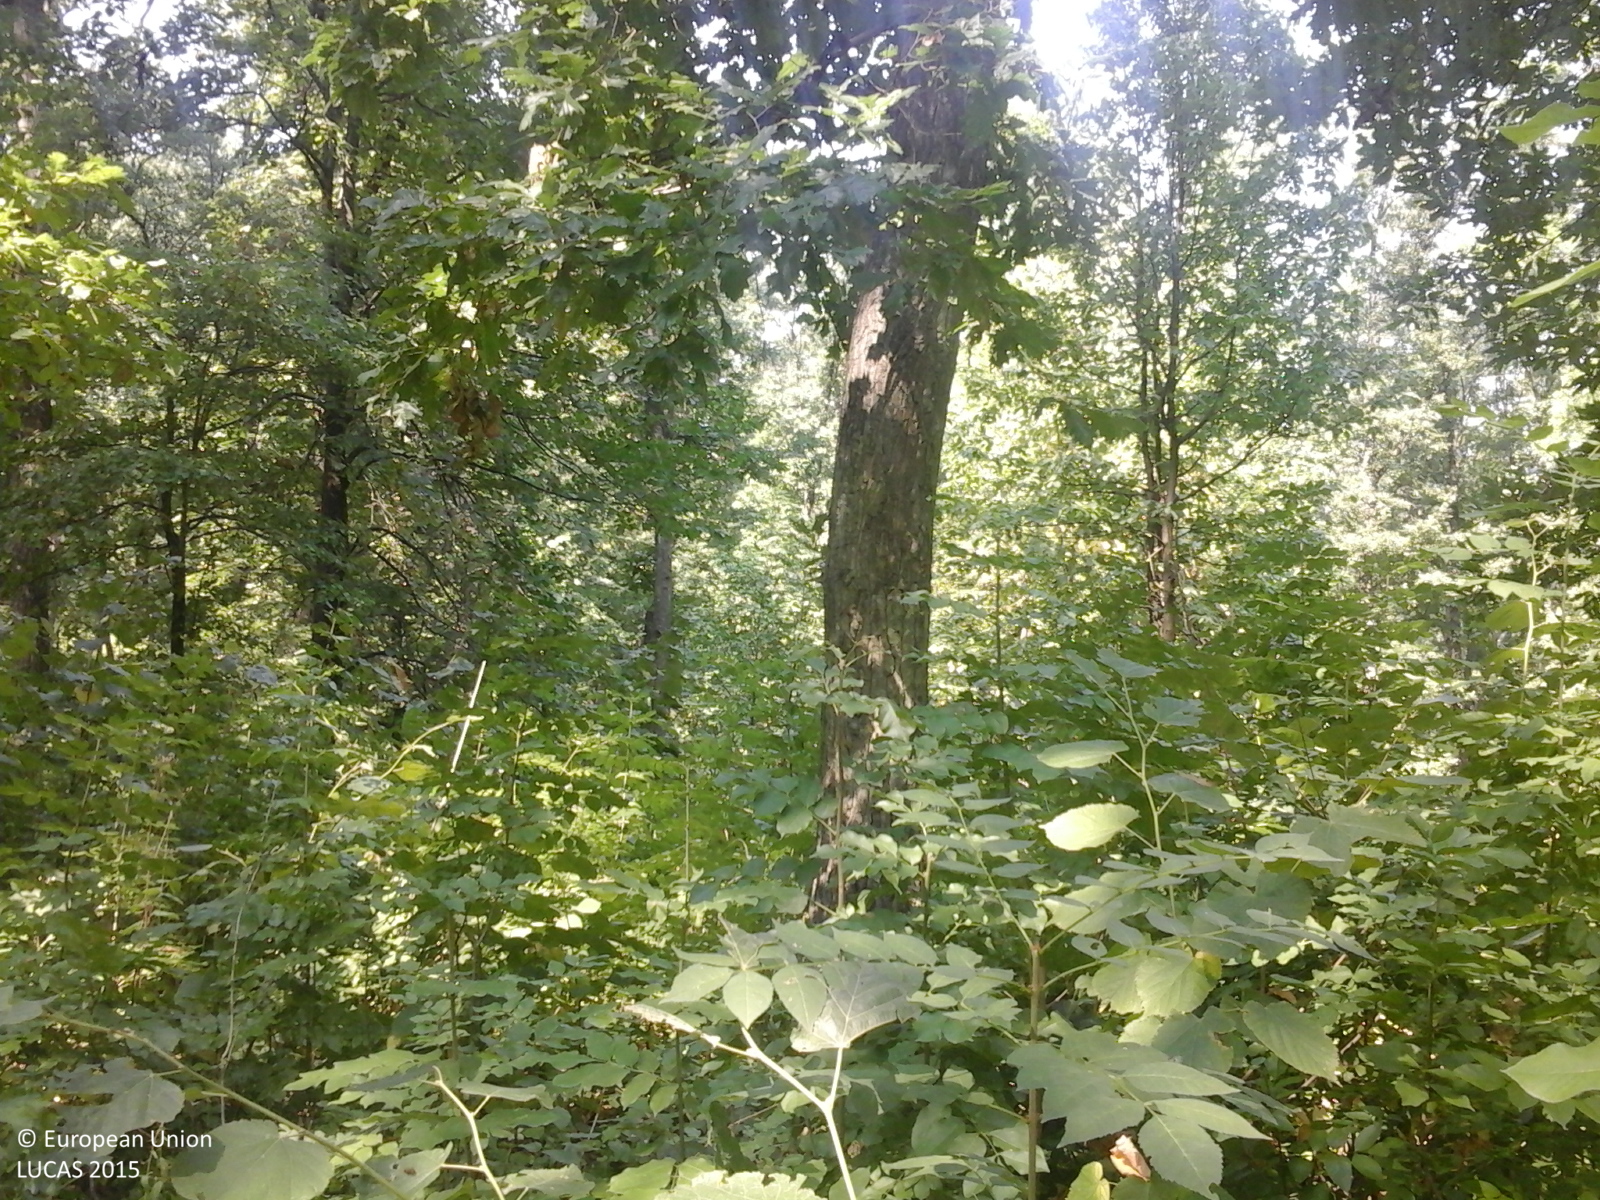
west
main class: Woodland
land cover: Broadleaved woodland
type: acidophilous oak and oak-birch forest
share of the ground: > 75 %
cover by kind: broadleaved forest trees 100 %
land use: Forestry
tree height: > 5 m
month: August
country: RO
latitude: 44.5497
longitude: 23.1520
